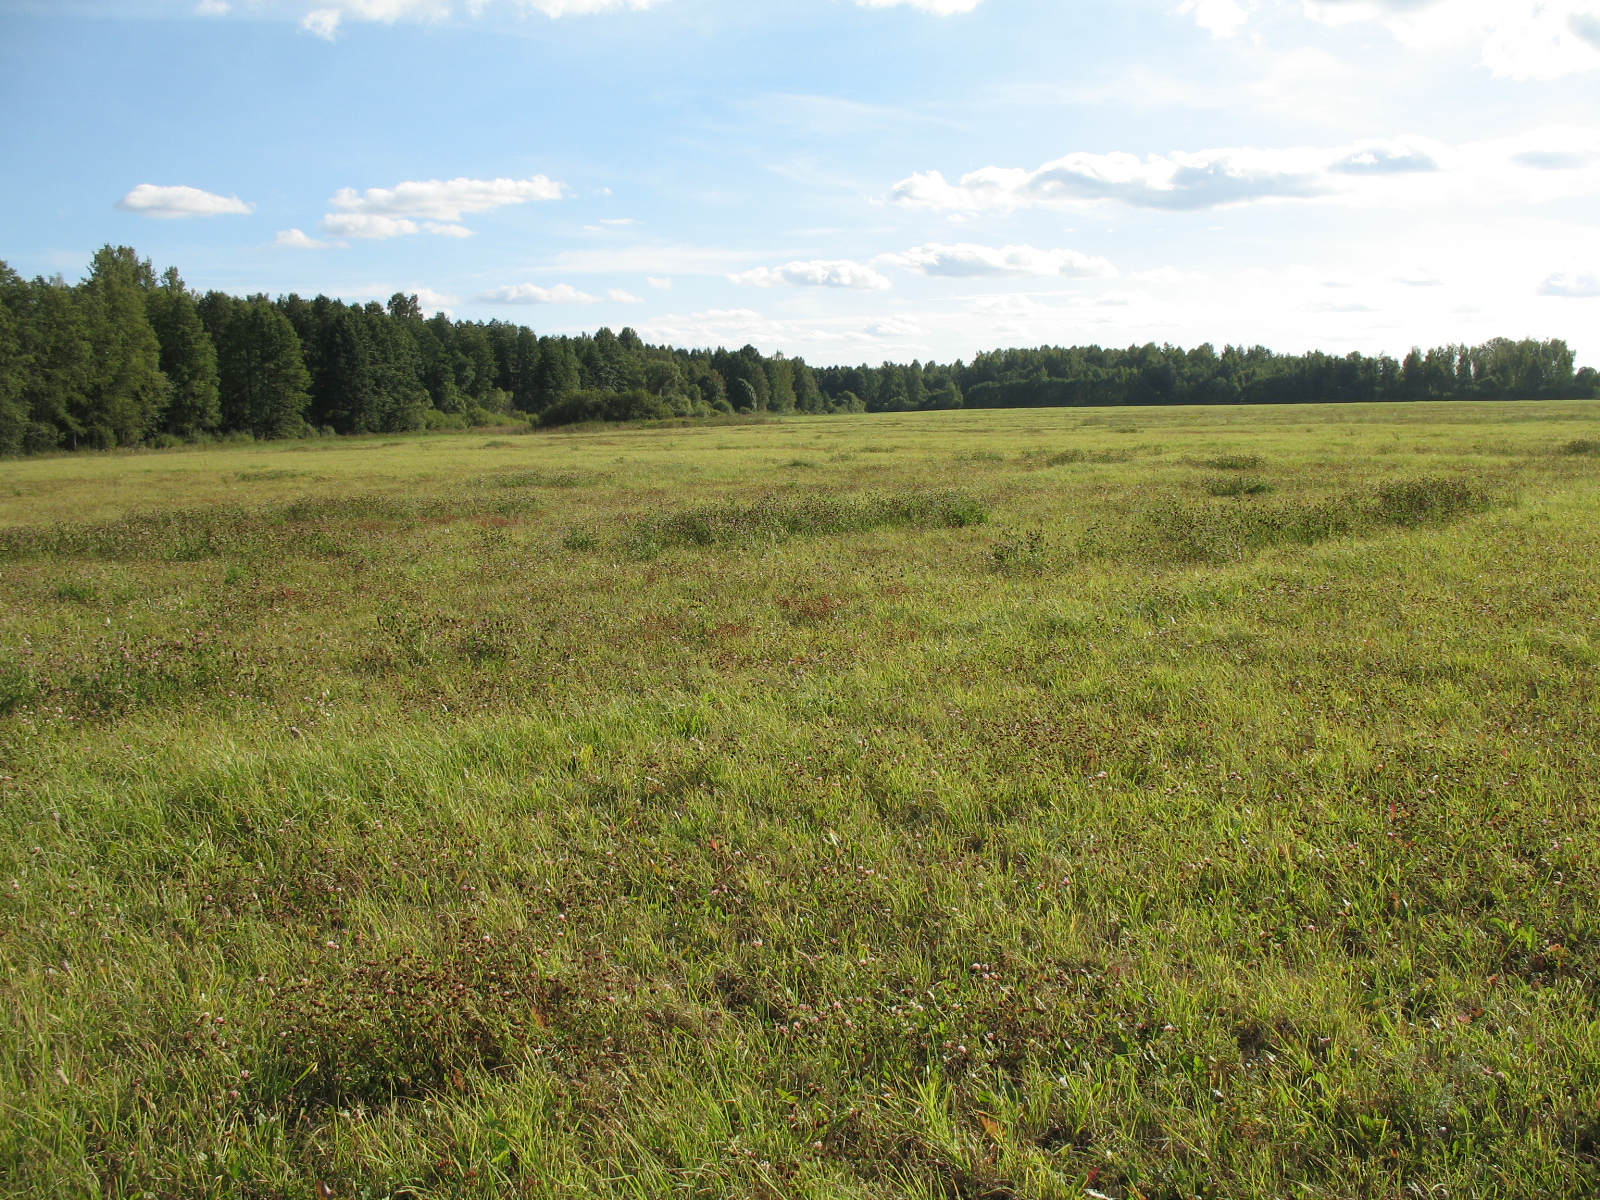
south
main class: Grassland
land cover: Grassland without tree/shrub cover
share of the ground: > 75 %
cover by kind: herbaceous plants 95 %, unconsolidated bare surface 5 %
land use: Agriculture (excluding fallow land and kitchen gardens)
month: August
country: LV
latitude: 56.2634
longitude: 26.1048
